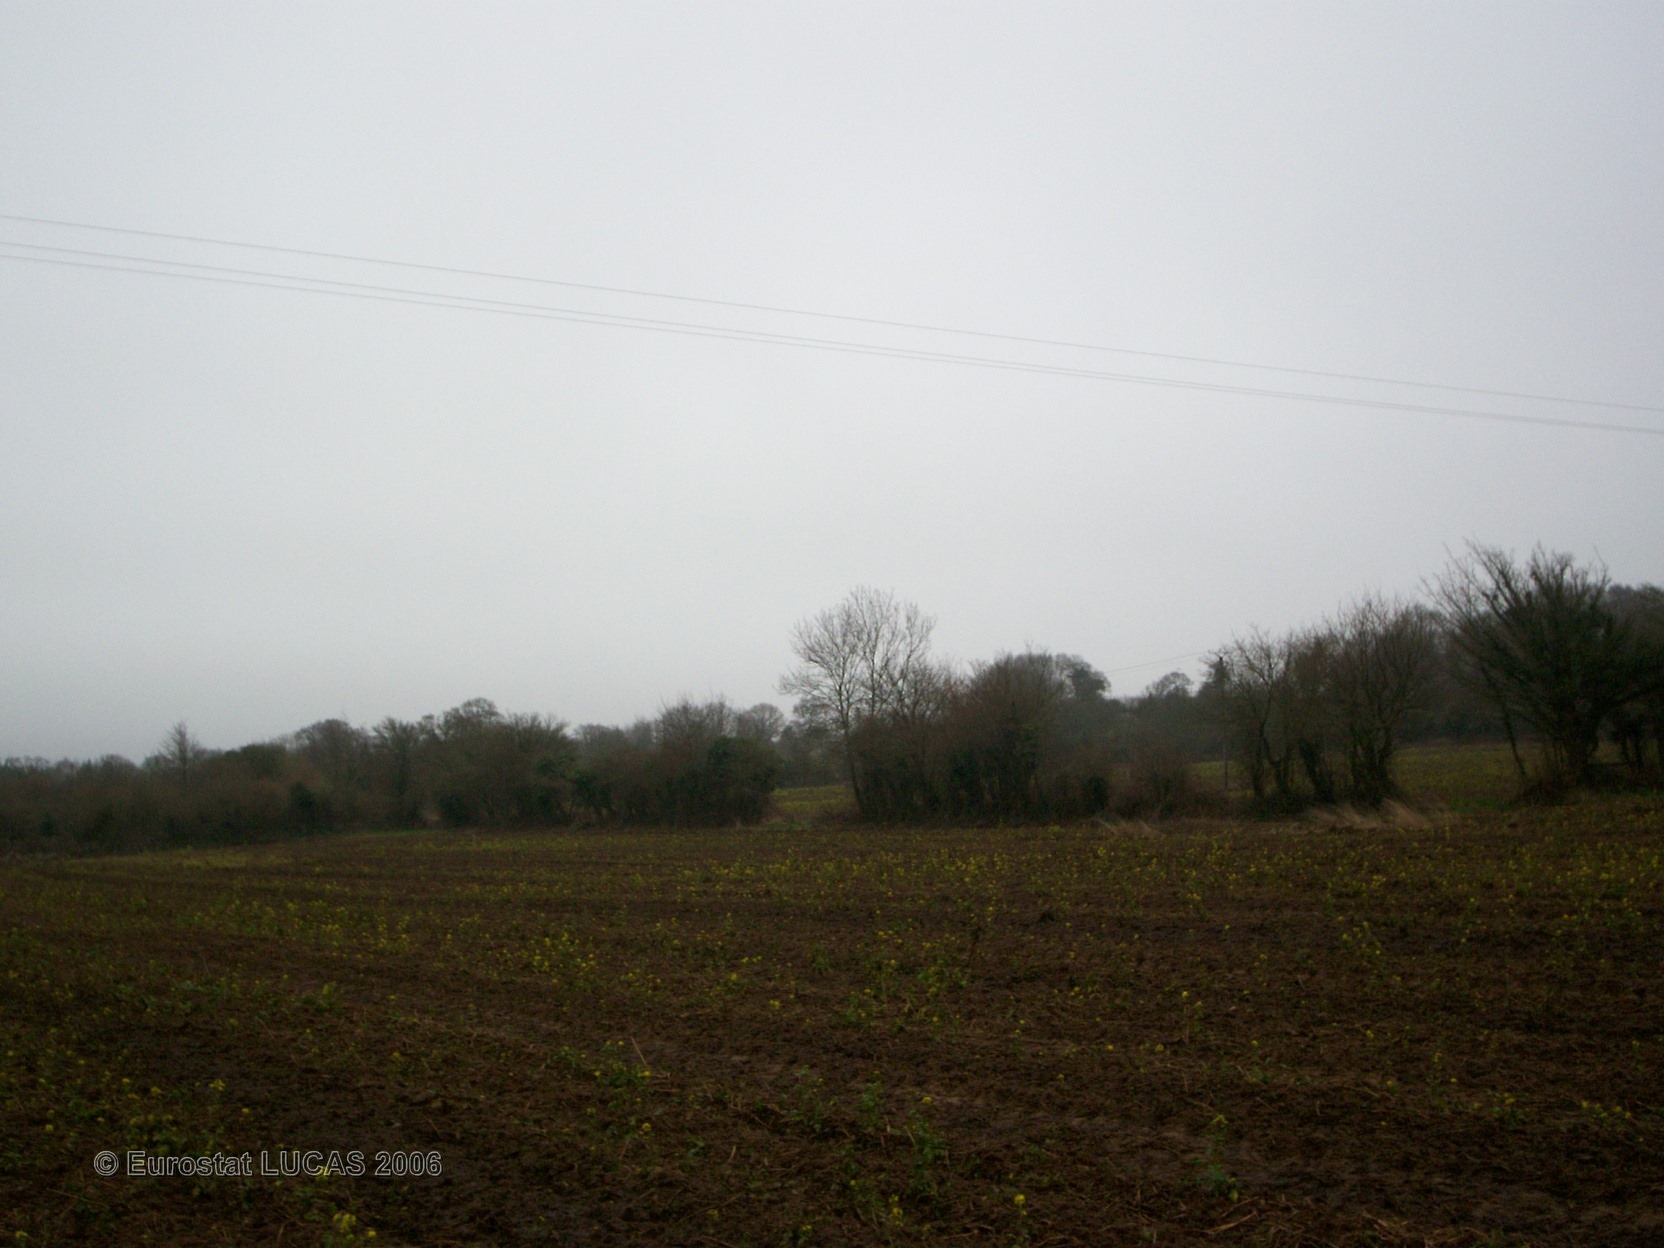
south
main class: Cropland
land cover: Maize
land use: Agriculture (excluding fallow land and kitchen gardens)
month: May
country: FR
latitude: 49.5159
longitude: -1.6120
